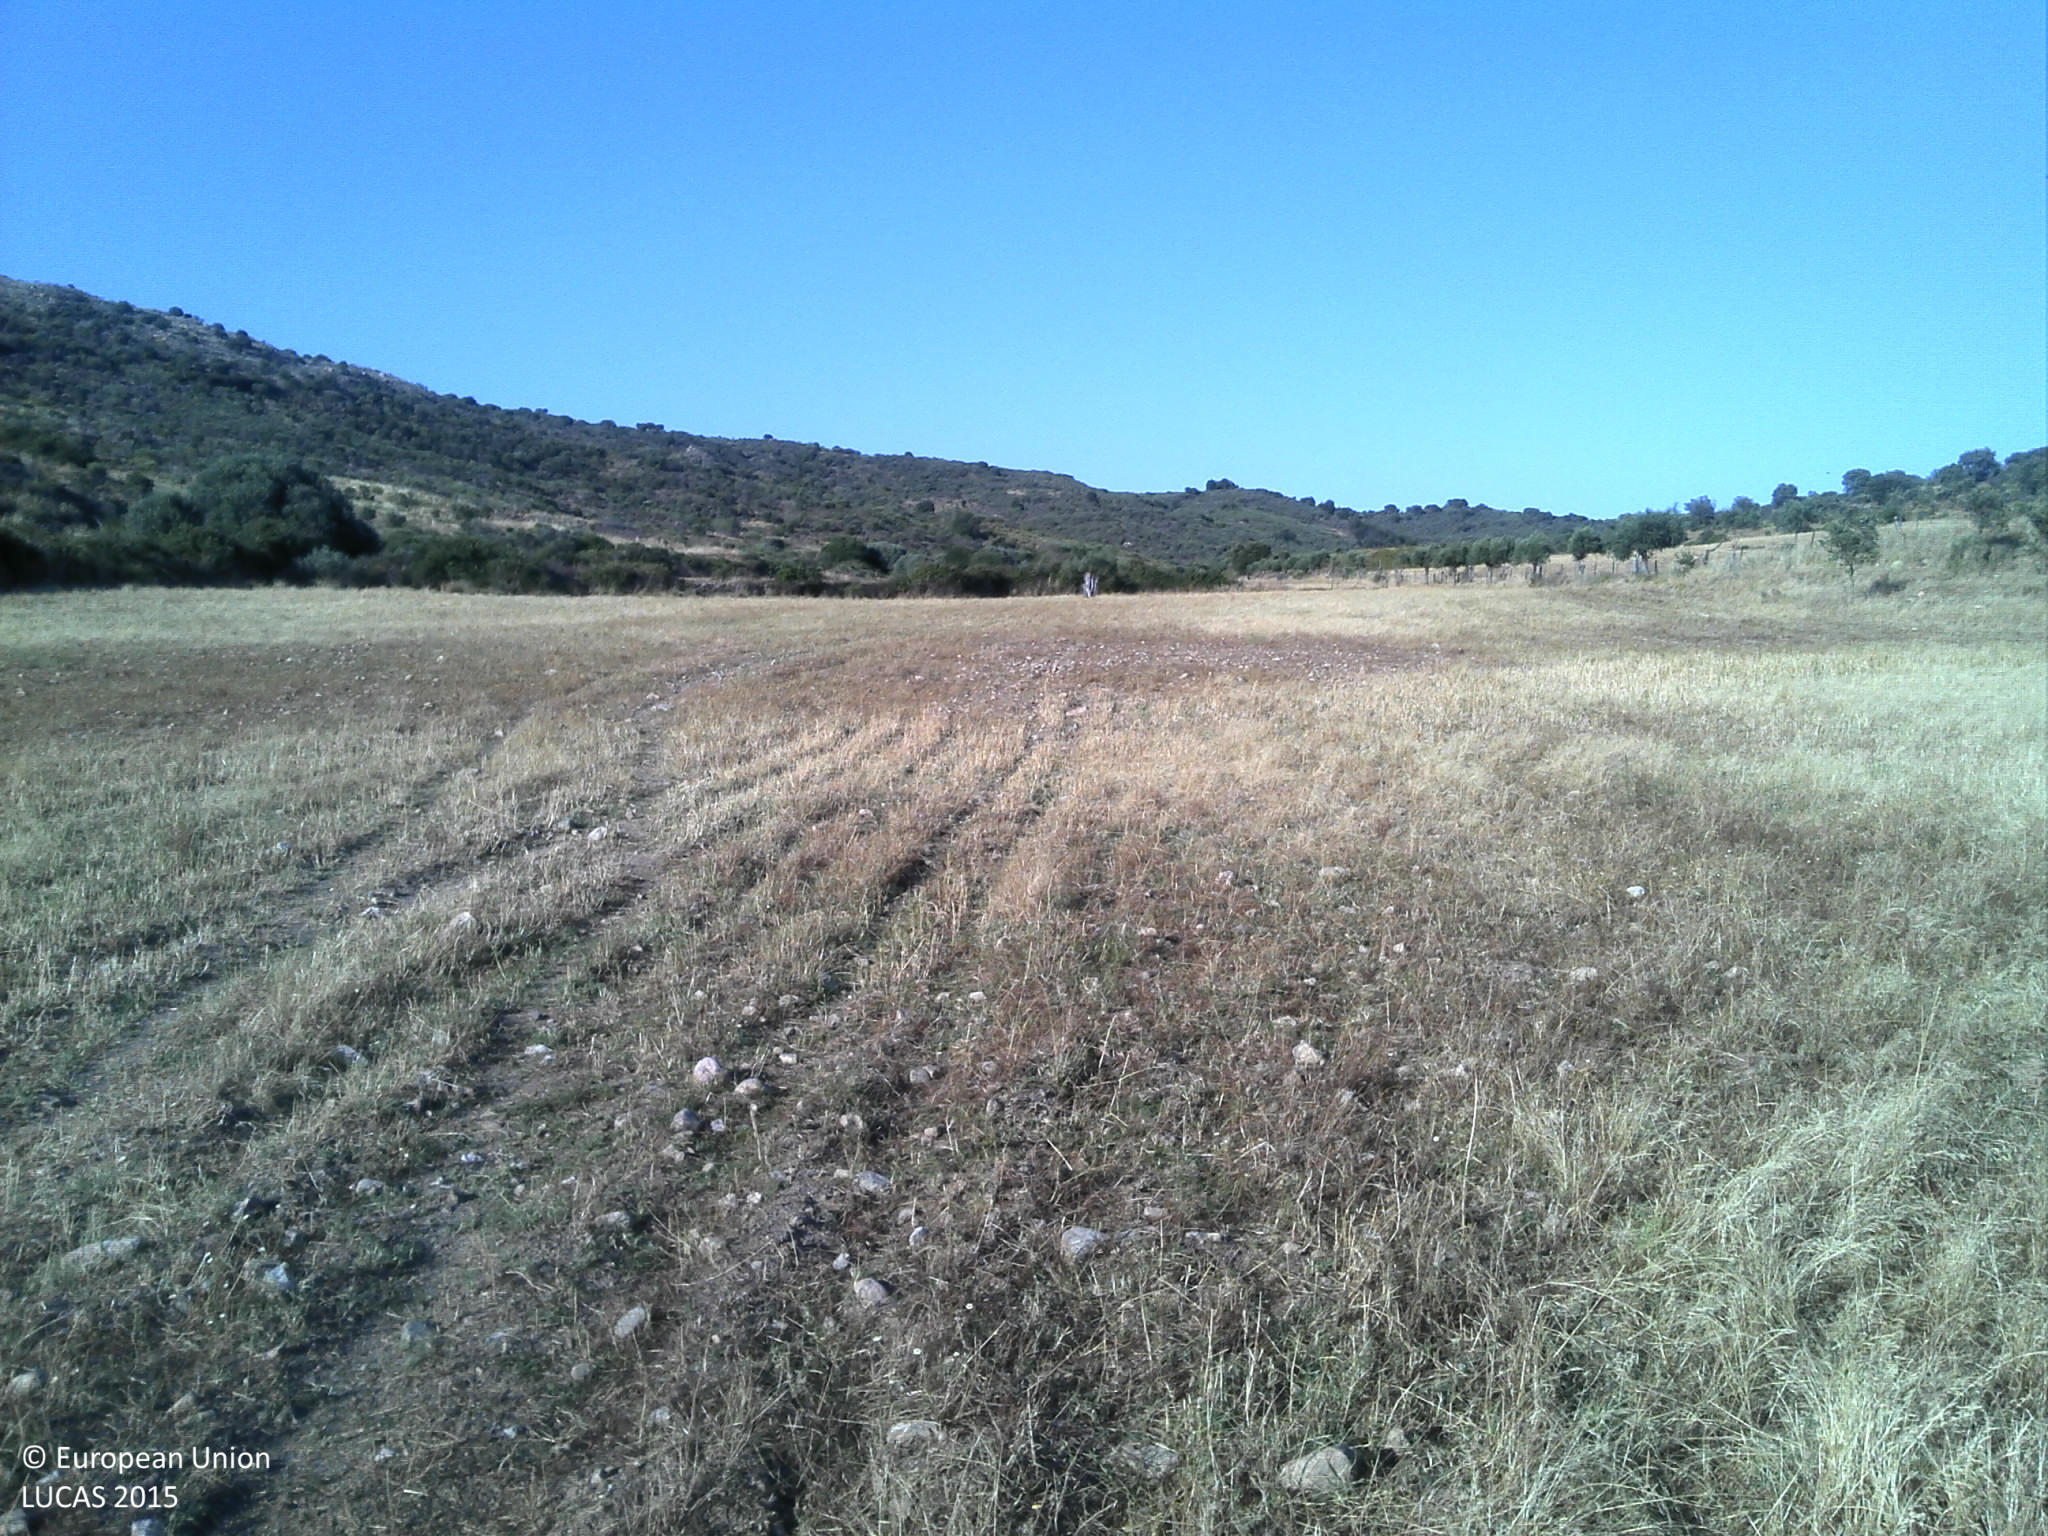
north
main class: Grassland
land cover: Grassland without tree/shrub cover
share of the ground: 50 - 75 %
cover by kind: herbaceous plants 60 %, unconsolidated bare surface 35 %
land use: Agriculture (excluding fallow land and kitchen gardens)
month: June
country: PT
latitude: 39.9901
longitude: -7.3017
